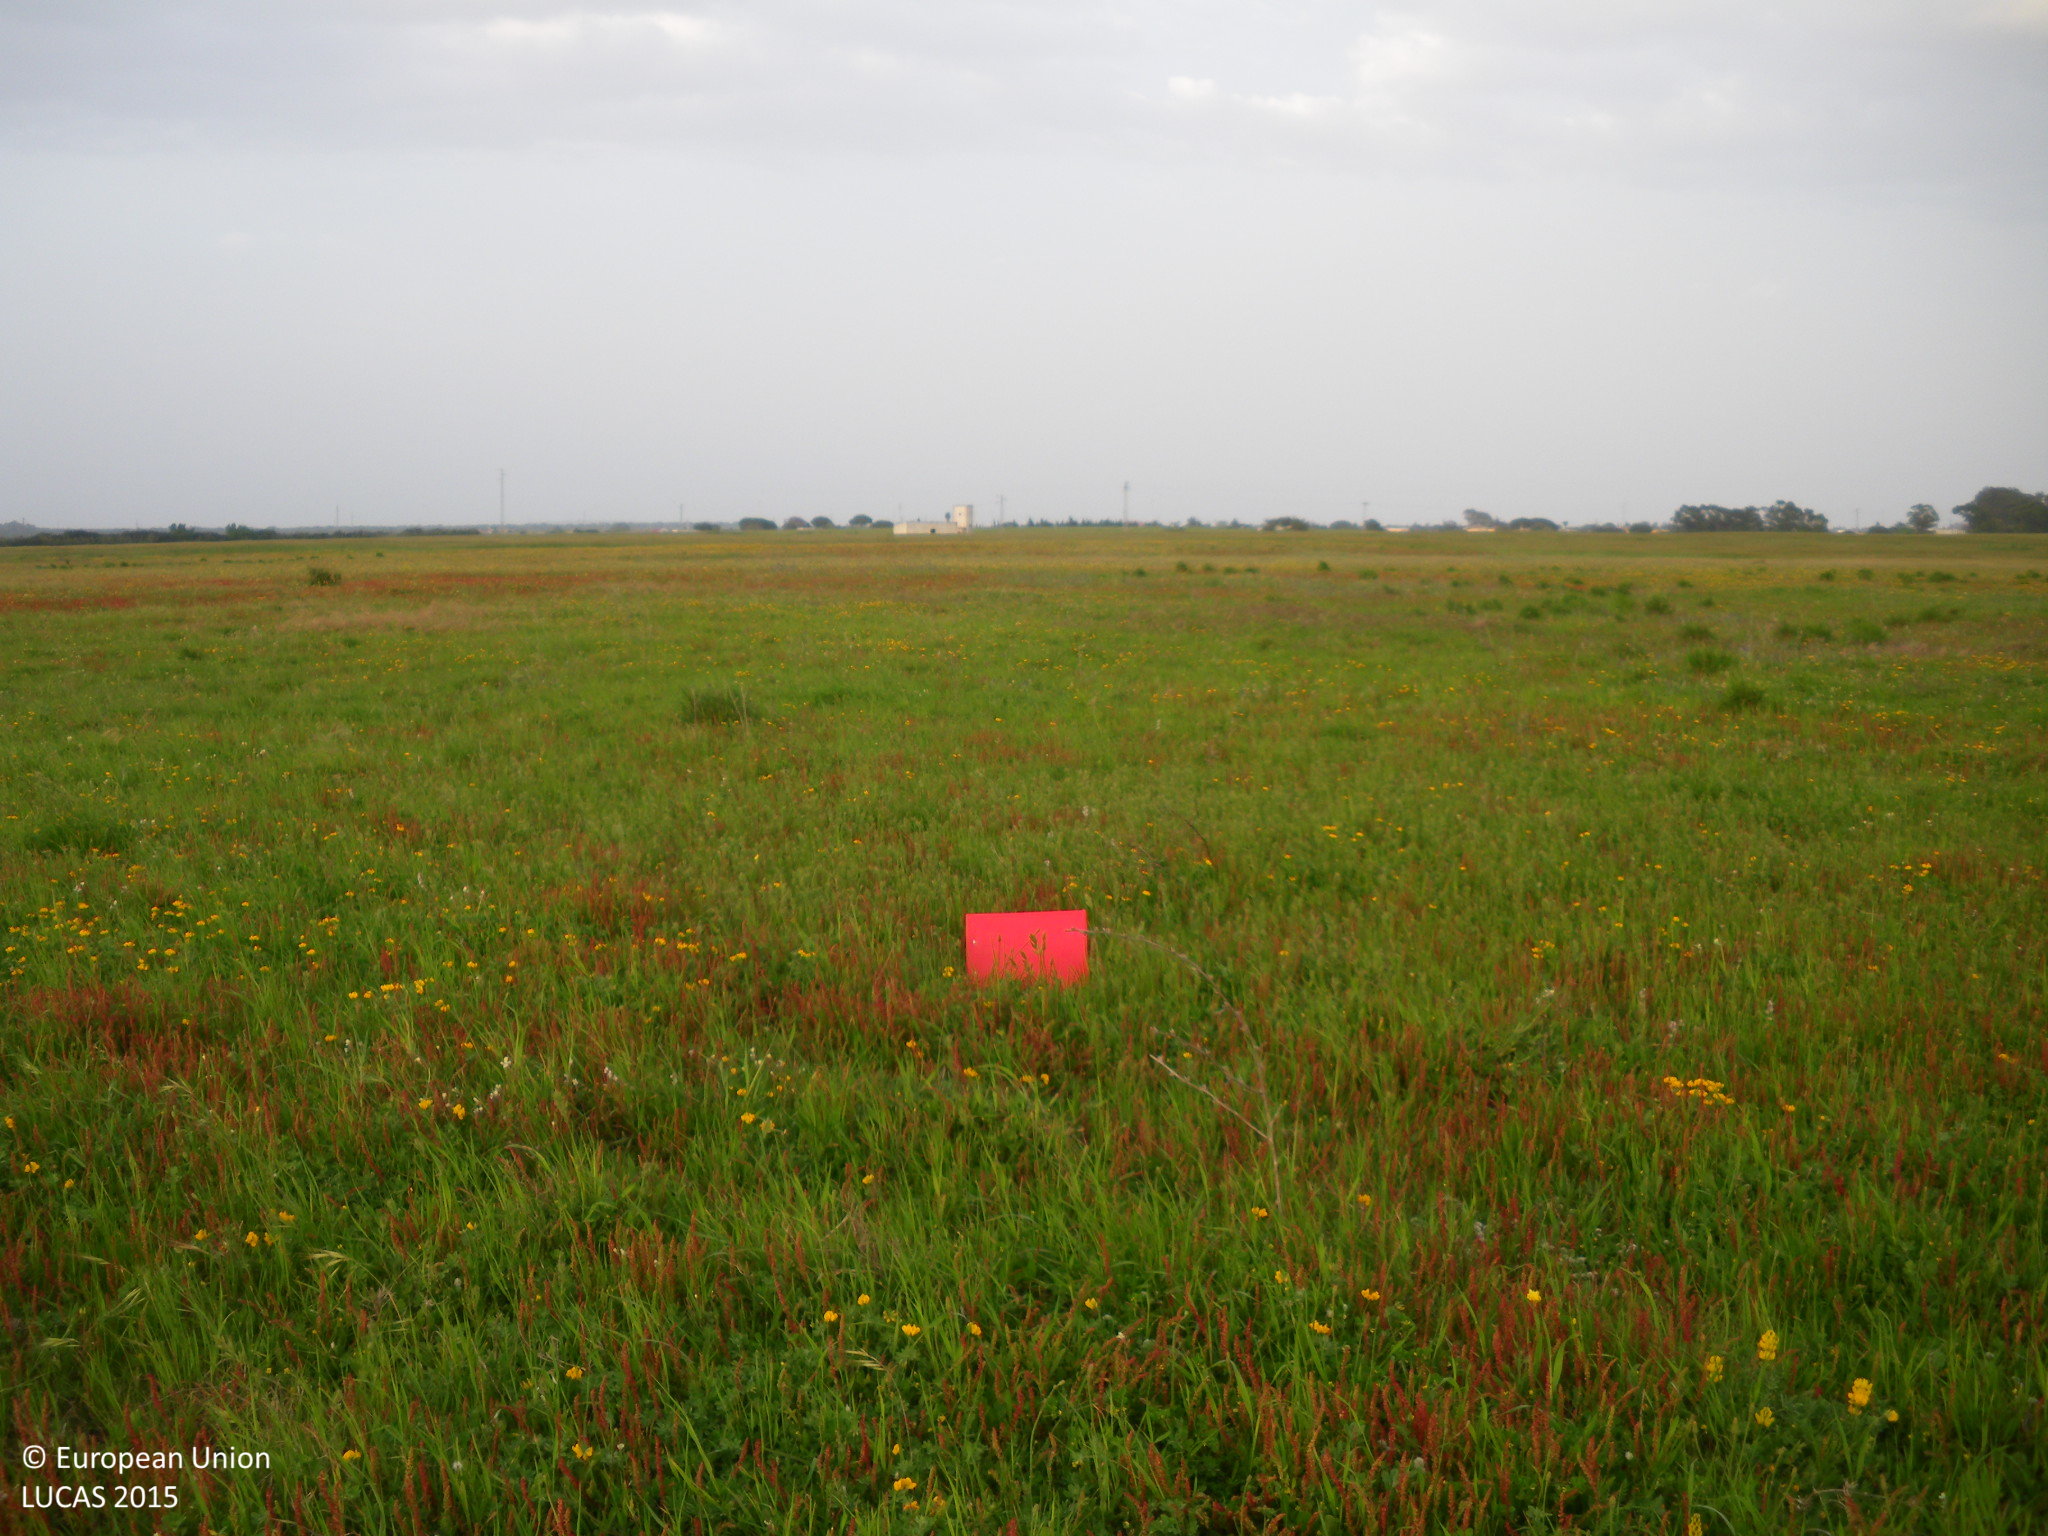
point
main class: Grassland
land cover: Spontaneously vegetated surfaces
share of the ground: > 75 %
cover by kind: herbaceous plants 100 %
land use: Fallow land
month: April
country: ES
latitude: 36.4707
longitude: -6.1342
